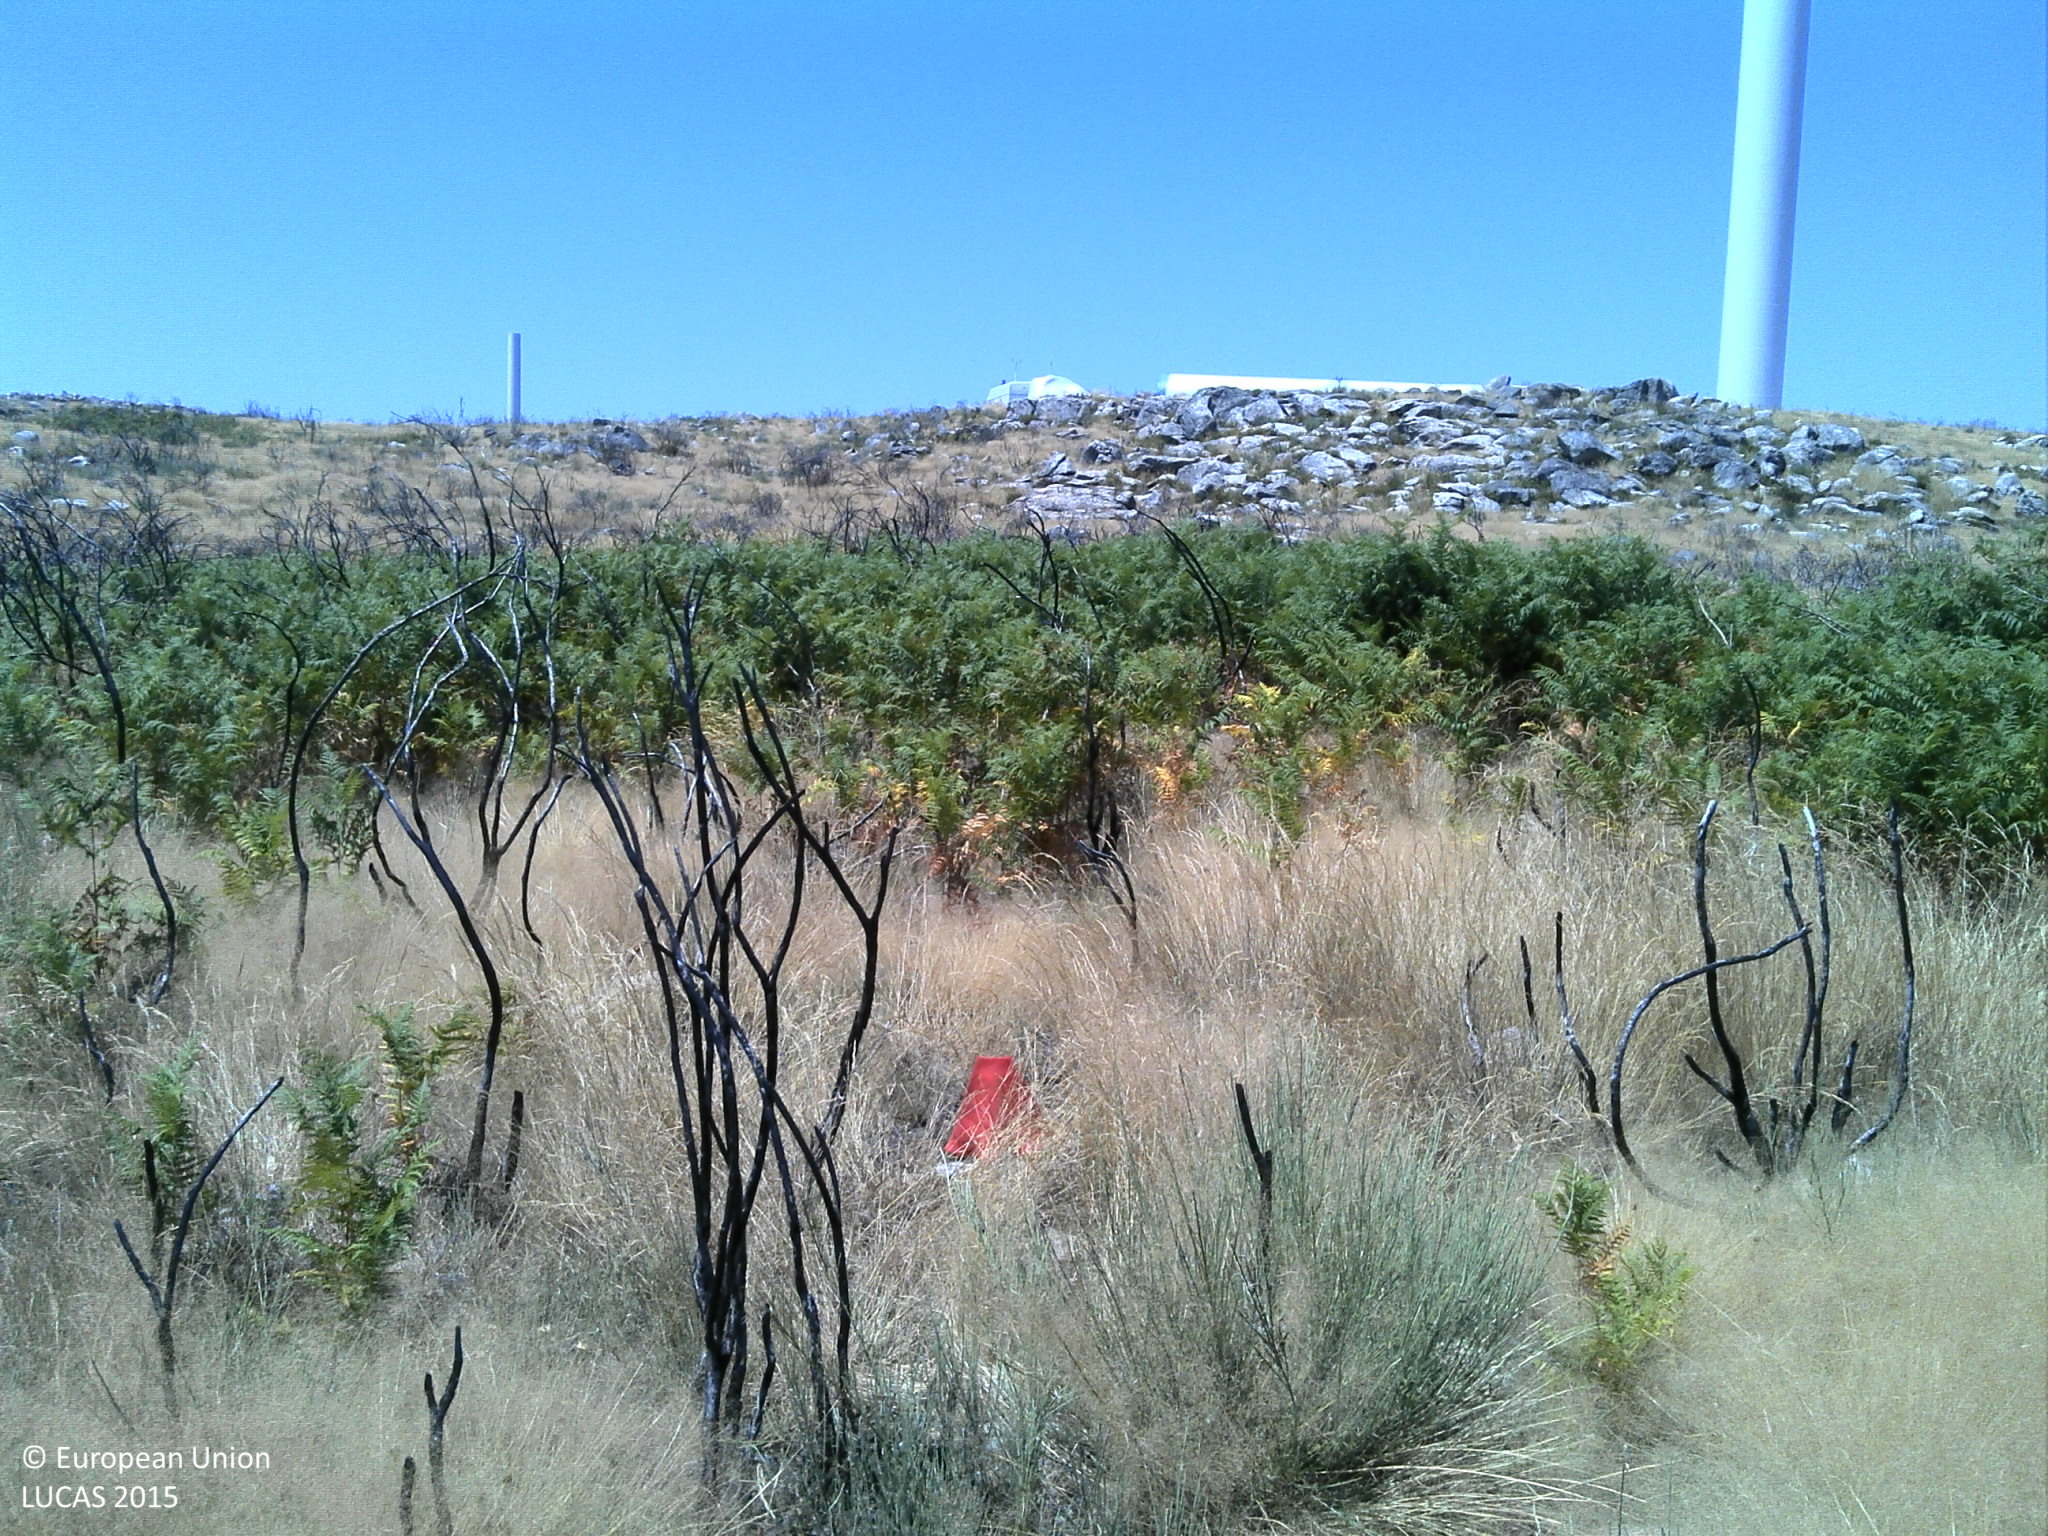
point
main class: Grassland
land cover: Grassland without tree/shrub cover
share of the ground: 50 - 75 %
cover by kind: herbaceous plants 60 %, consolidated bare surface 20 %, unconsolidated bare surface 15 %, shrubs 5 %
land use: Semi-natural and natural areas not in use
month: July
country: PT
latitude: 40.8754
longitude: -7.4038
